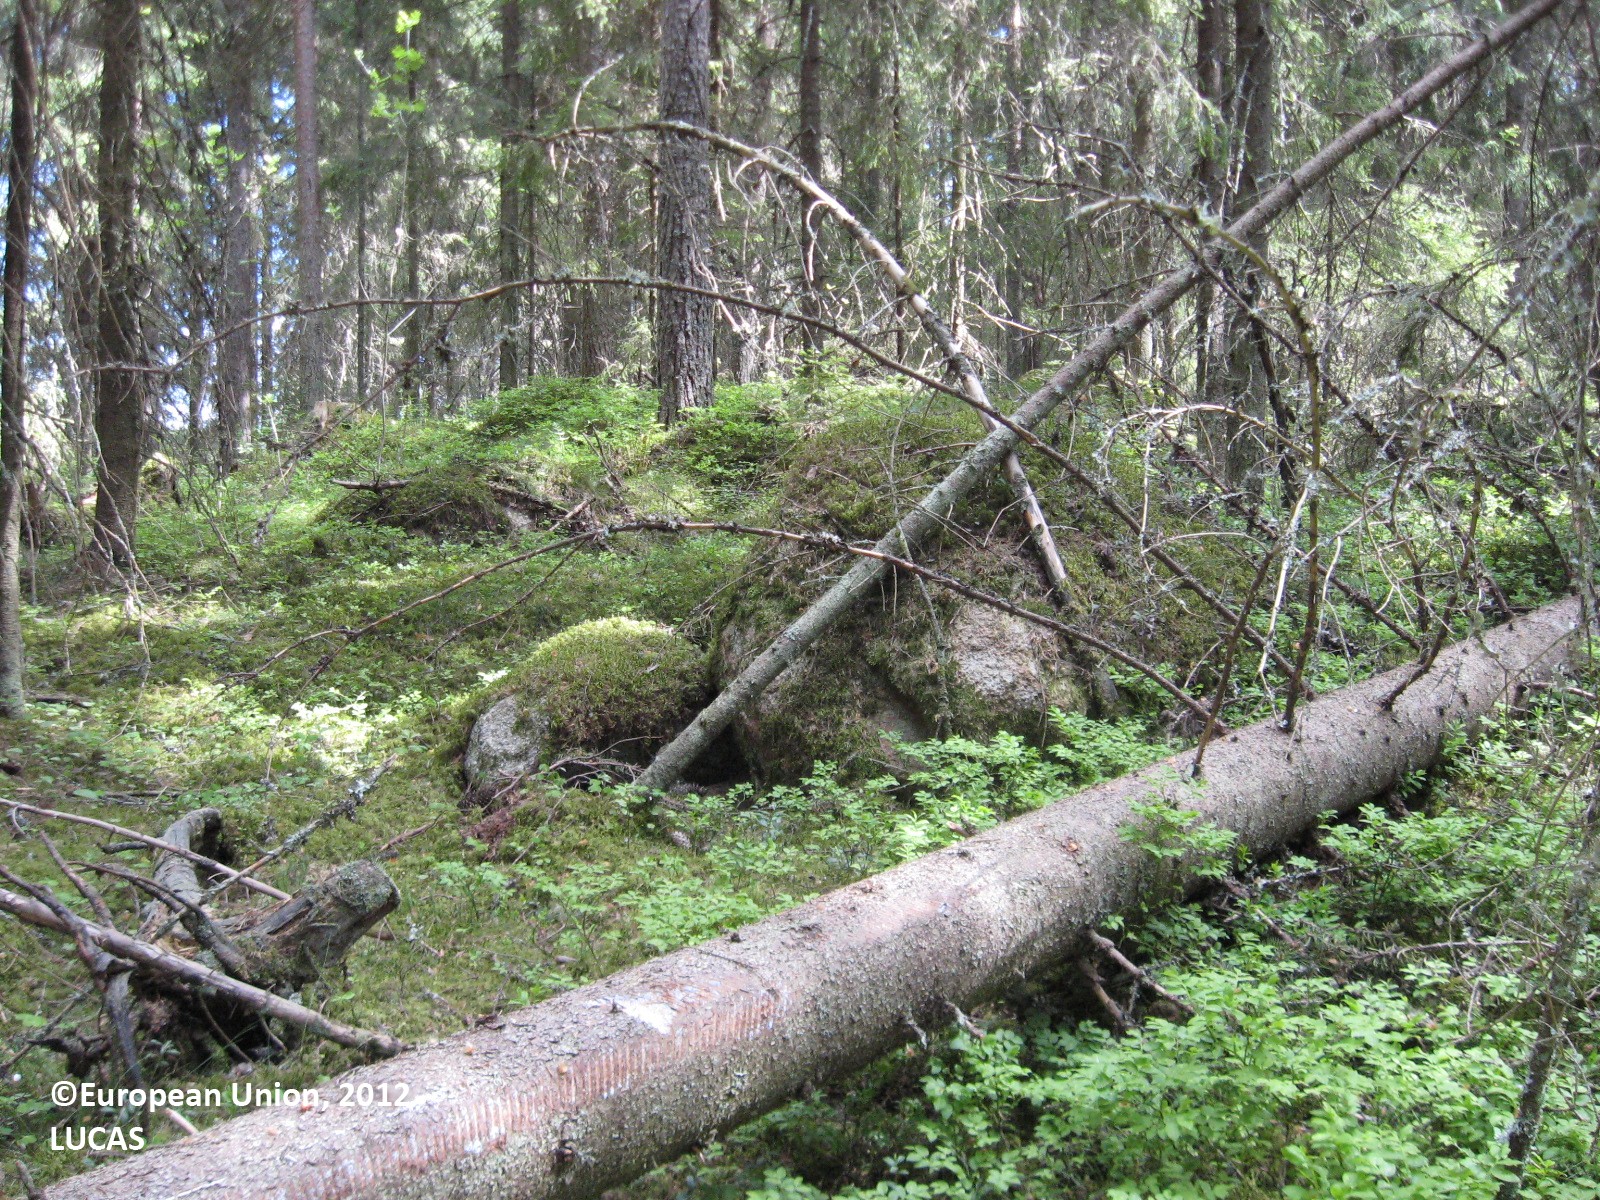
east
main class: Woodland
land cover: Spruce dominated coniferous woodland
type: boreal forest
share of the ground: > 75 %
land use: Forestry
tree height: > 5 m
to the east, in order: Spruce dominated coniferous woodland; Tracks; Spontaneously vegetated surfaces; Electric lines; Paved roads, cycling and walking lanes; Spruce dominated coniferous woodland; Broadleaved woodland; Inland water bodies
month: May
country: FI
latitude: 61.7926
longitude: 22.3292
